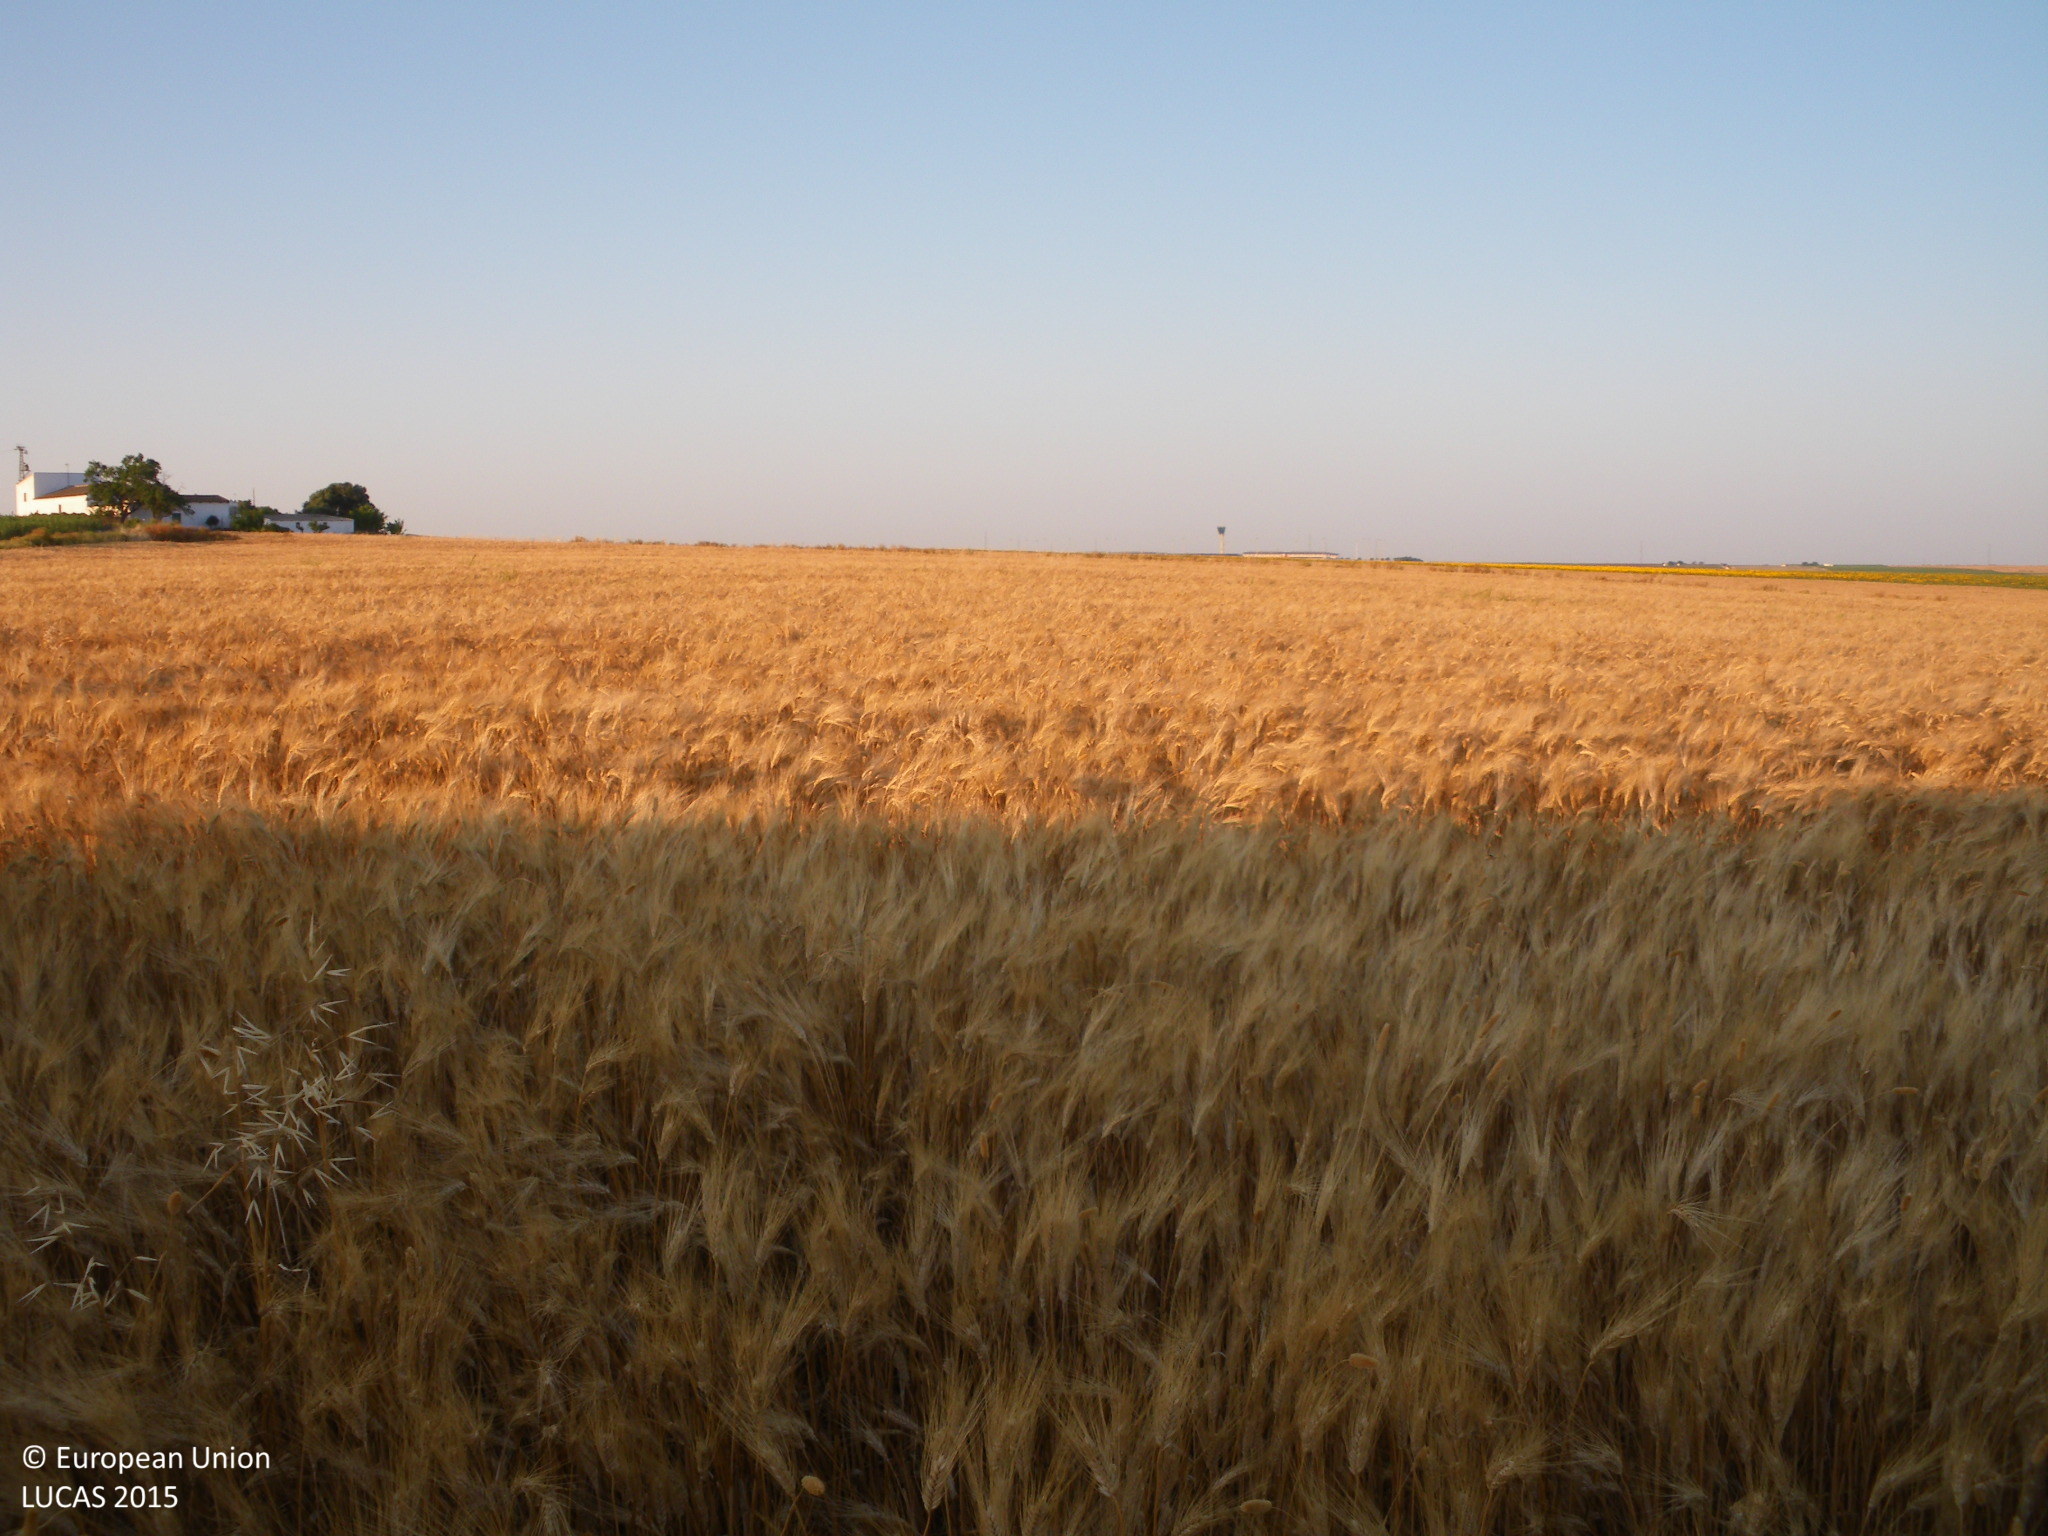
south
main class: Grassland
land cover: Grassland without tree/shrub cover
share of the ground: > 75 %
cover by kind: herbaceous plants 95 %, unconsolidated bare surface 5 %
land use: Semi-natural and natural areas not in use
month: May
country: ES
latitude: 36.6897
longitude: -6.2534
